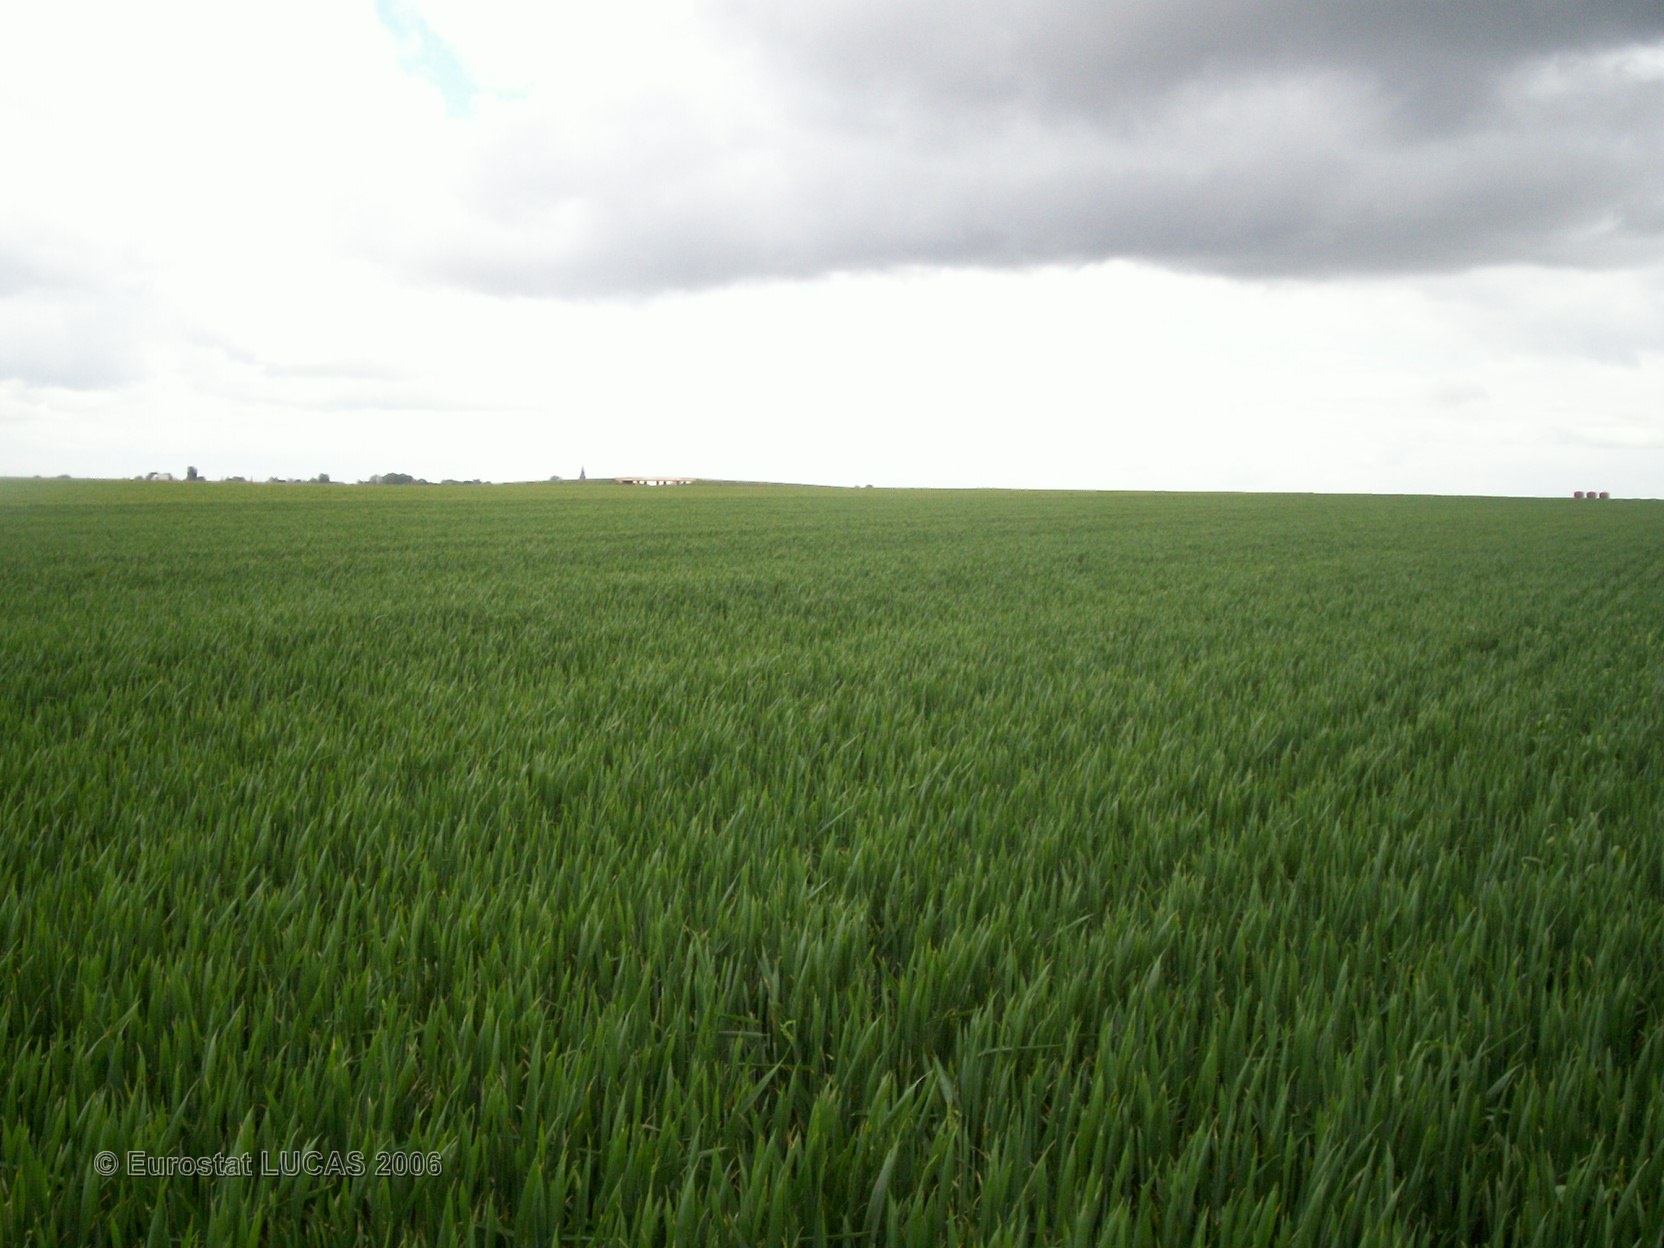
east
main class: Cropland
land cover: Common wheat
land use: Agriculture (excluding fallow land and kitchen gardens)
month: May
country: FR
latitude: 49.8535
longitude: 2.6027
